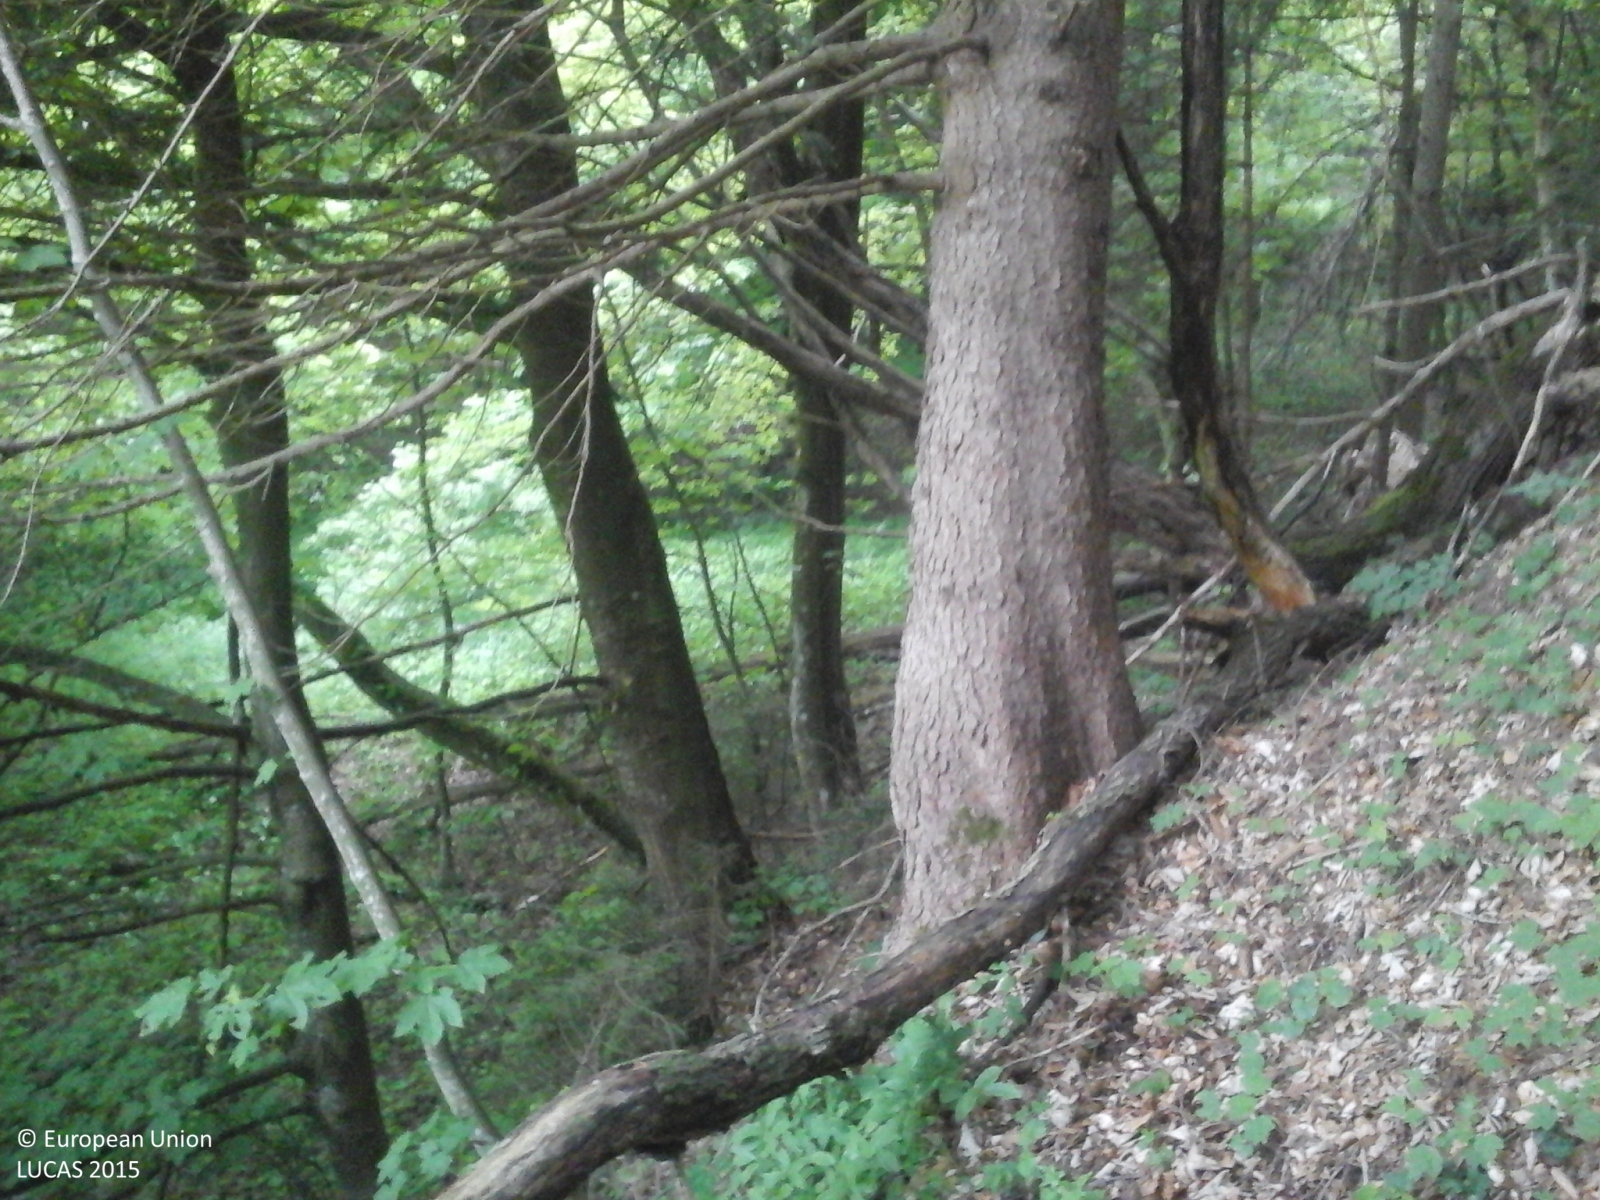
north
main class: Woodland
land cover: Other mixed woodland
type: alpine coniferous forest
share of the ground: > 75 %
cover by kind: coniferous forest trees 50 %, broadleaved forest trees 50 %
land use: Forestry
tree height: > 5 m
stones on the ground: < 10 %
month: May
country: IT
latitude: 45.8784
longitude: 10.9649
